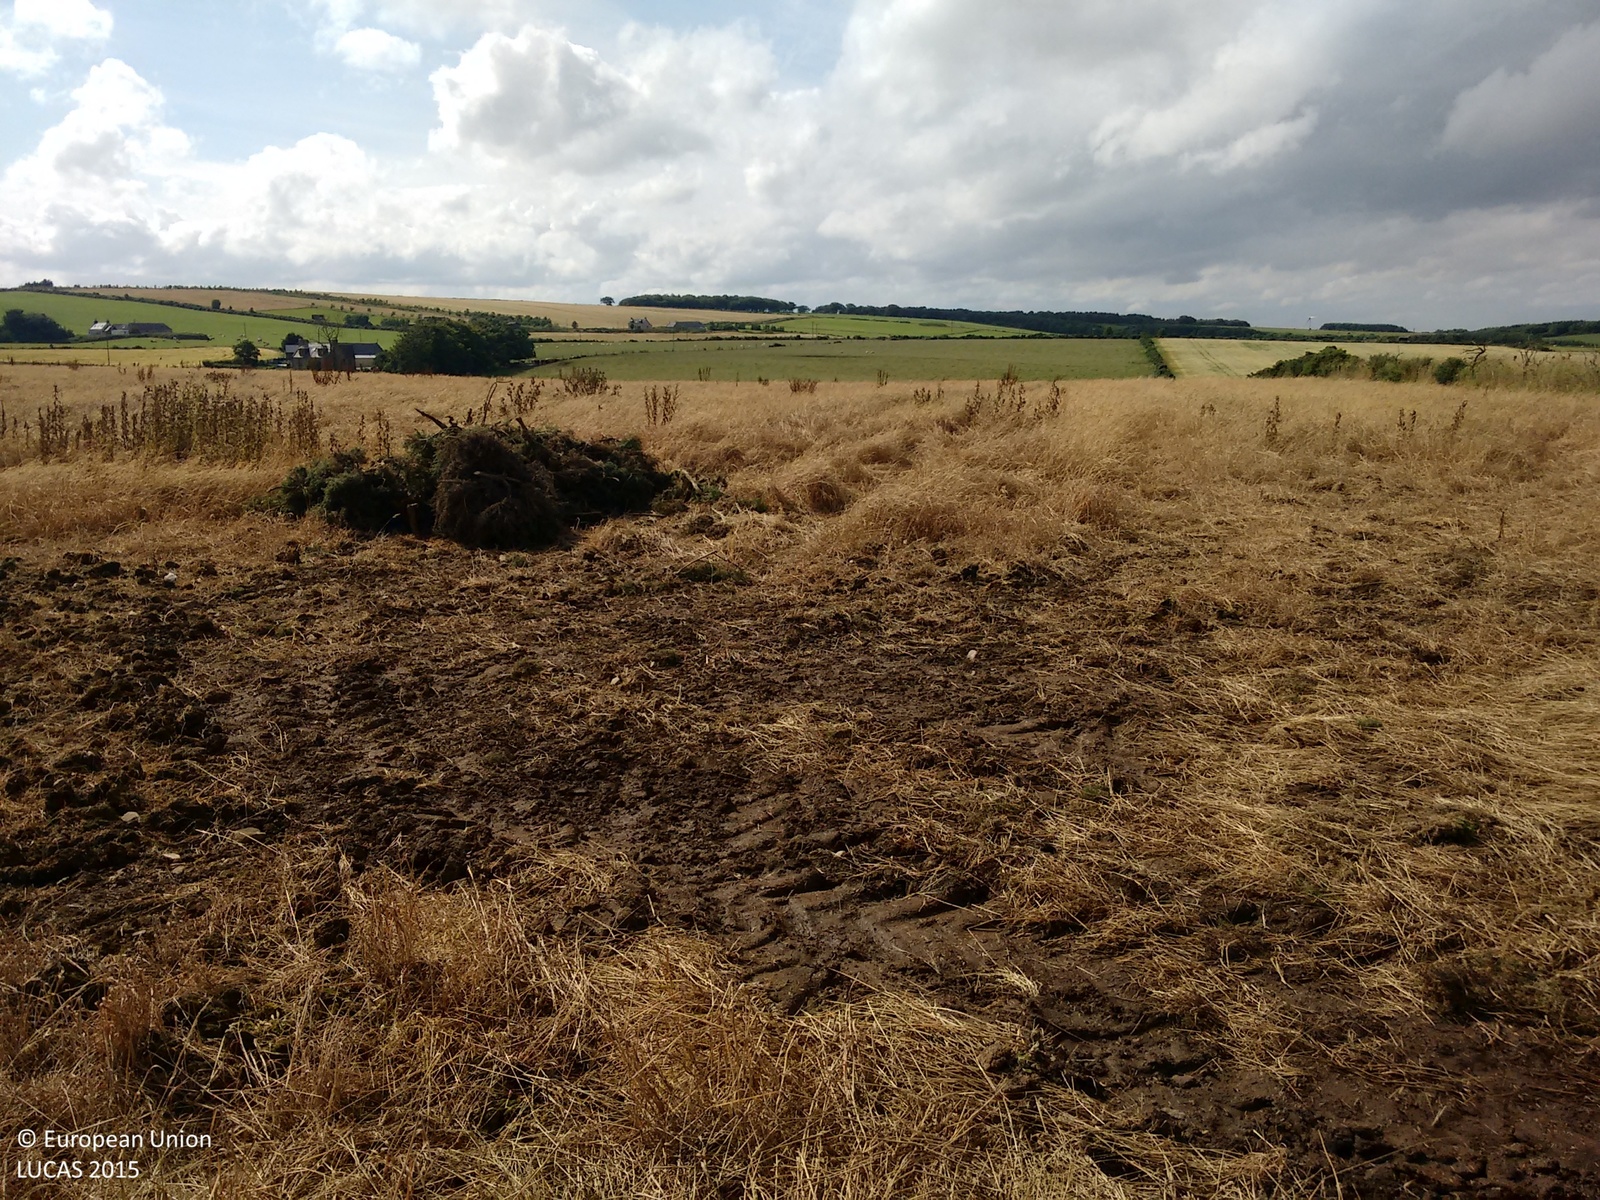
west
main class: Grassland
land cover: Grassland without tree/shrub cover
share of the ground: 50 - 75 %
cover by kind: herbaceous plants 75 %, unconsolidated bare surface 25 %
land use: Agriculture (excluding fallow land and kitchen gardens)
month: August
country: GB
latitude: 57.5491
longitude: -2.2296
